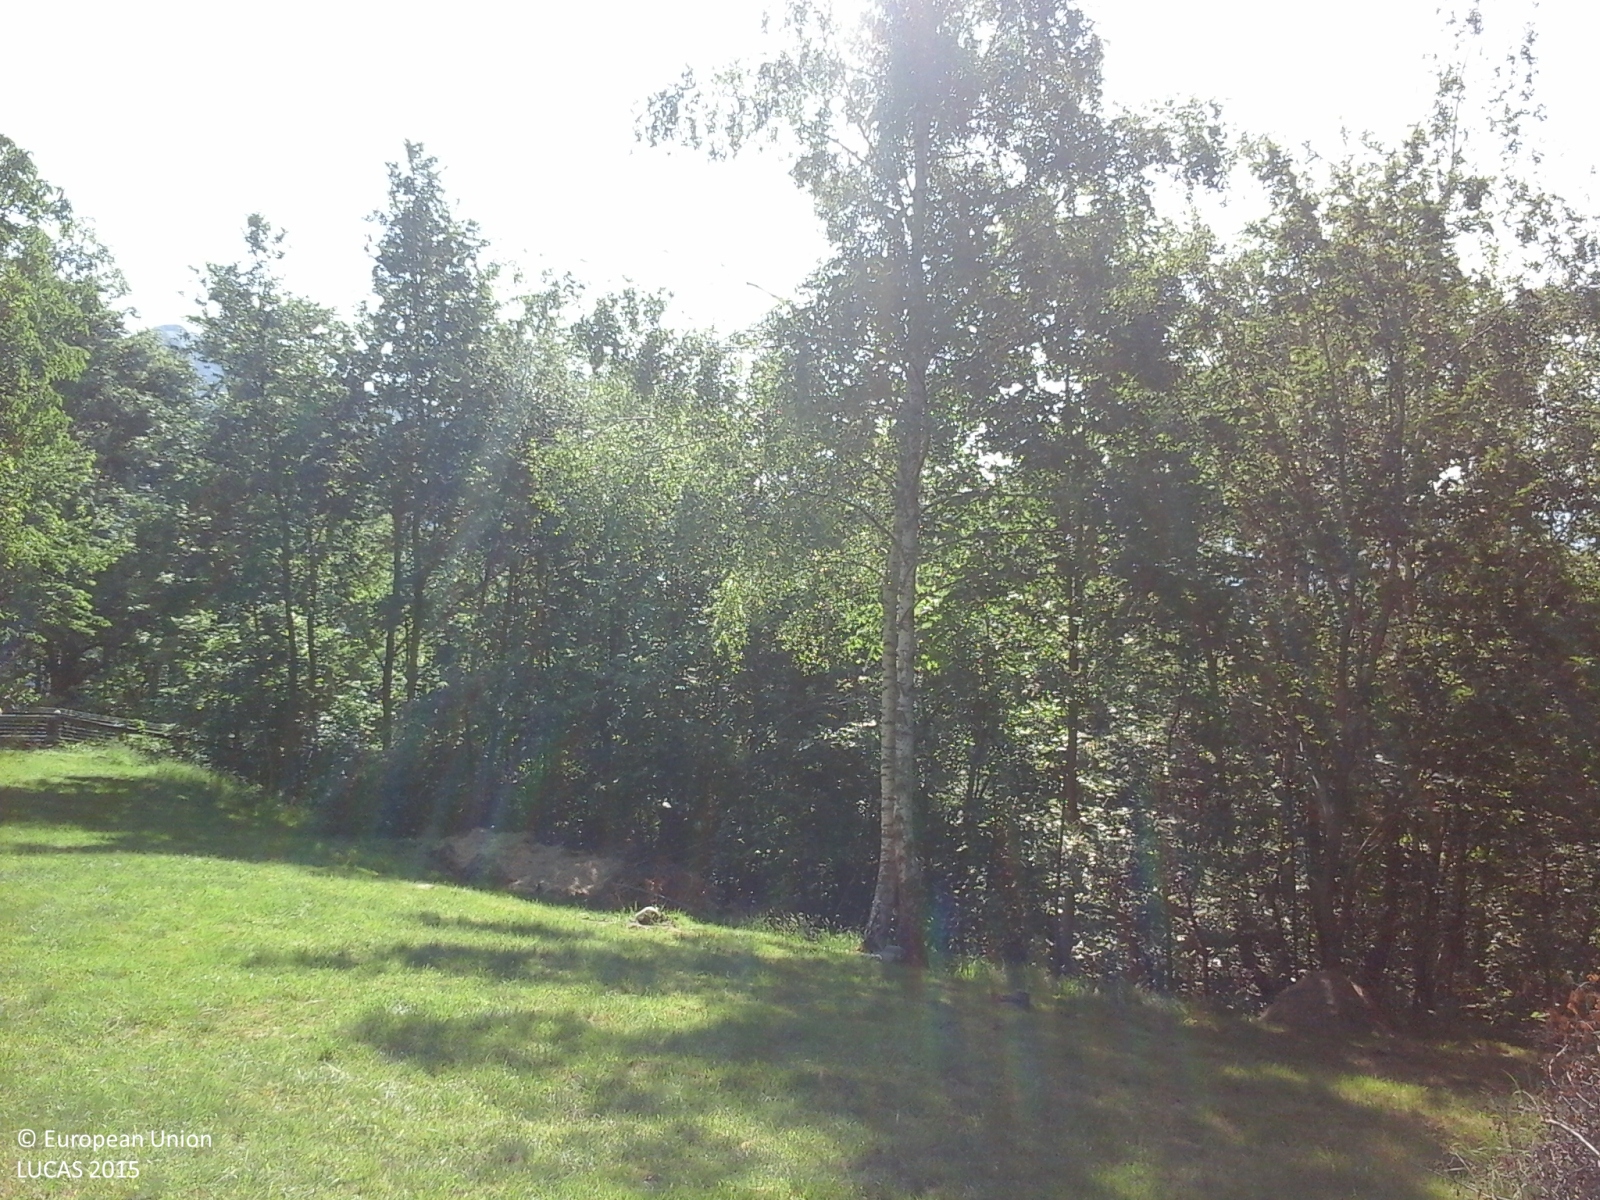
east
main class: Woodland
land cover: Broadleaved woodland
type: mesophytic deciduous forest
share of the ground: > 75 %
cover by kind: broadleaved forest trees 100 %
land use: Forestry
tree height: > 5 m
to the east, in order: Broadleaved woodland; Grassland without tree/shrub cover; Artificial constructions in urban areas; Broadleaved woodland
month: June
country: IT
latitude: 45.9799
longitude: 8.4662
